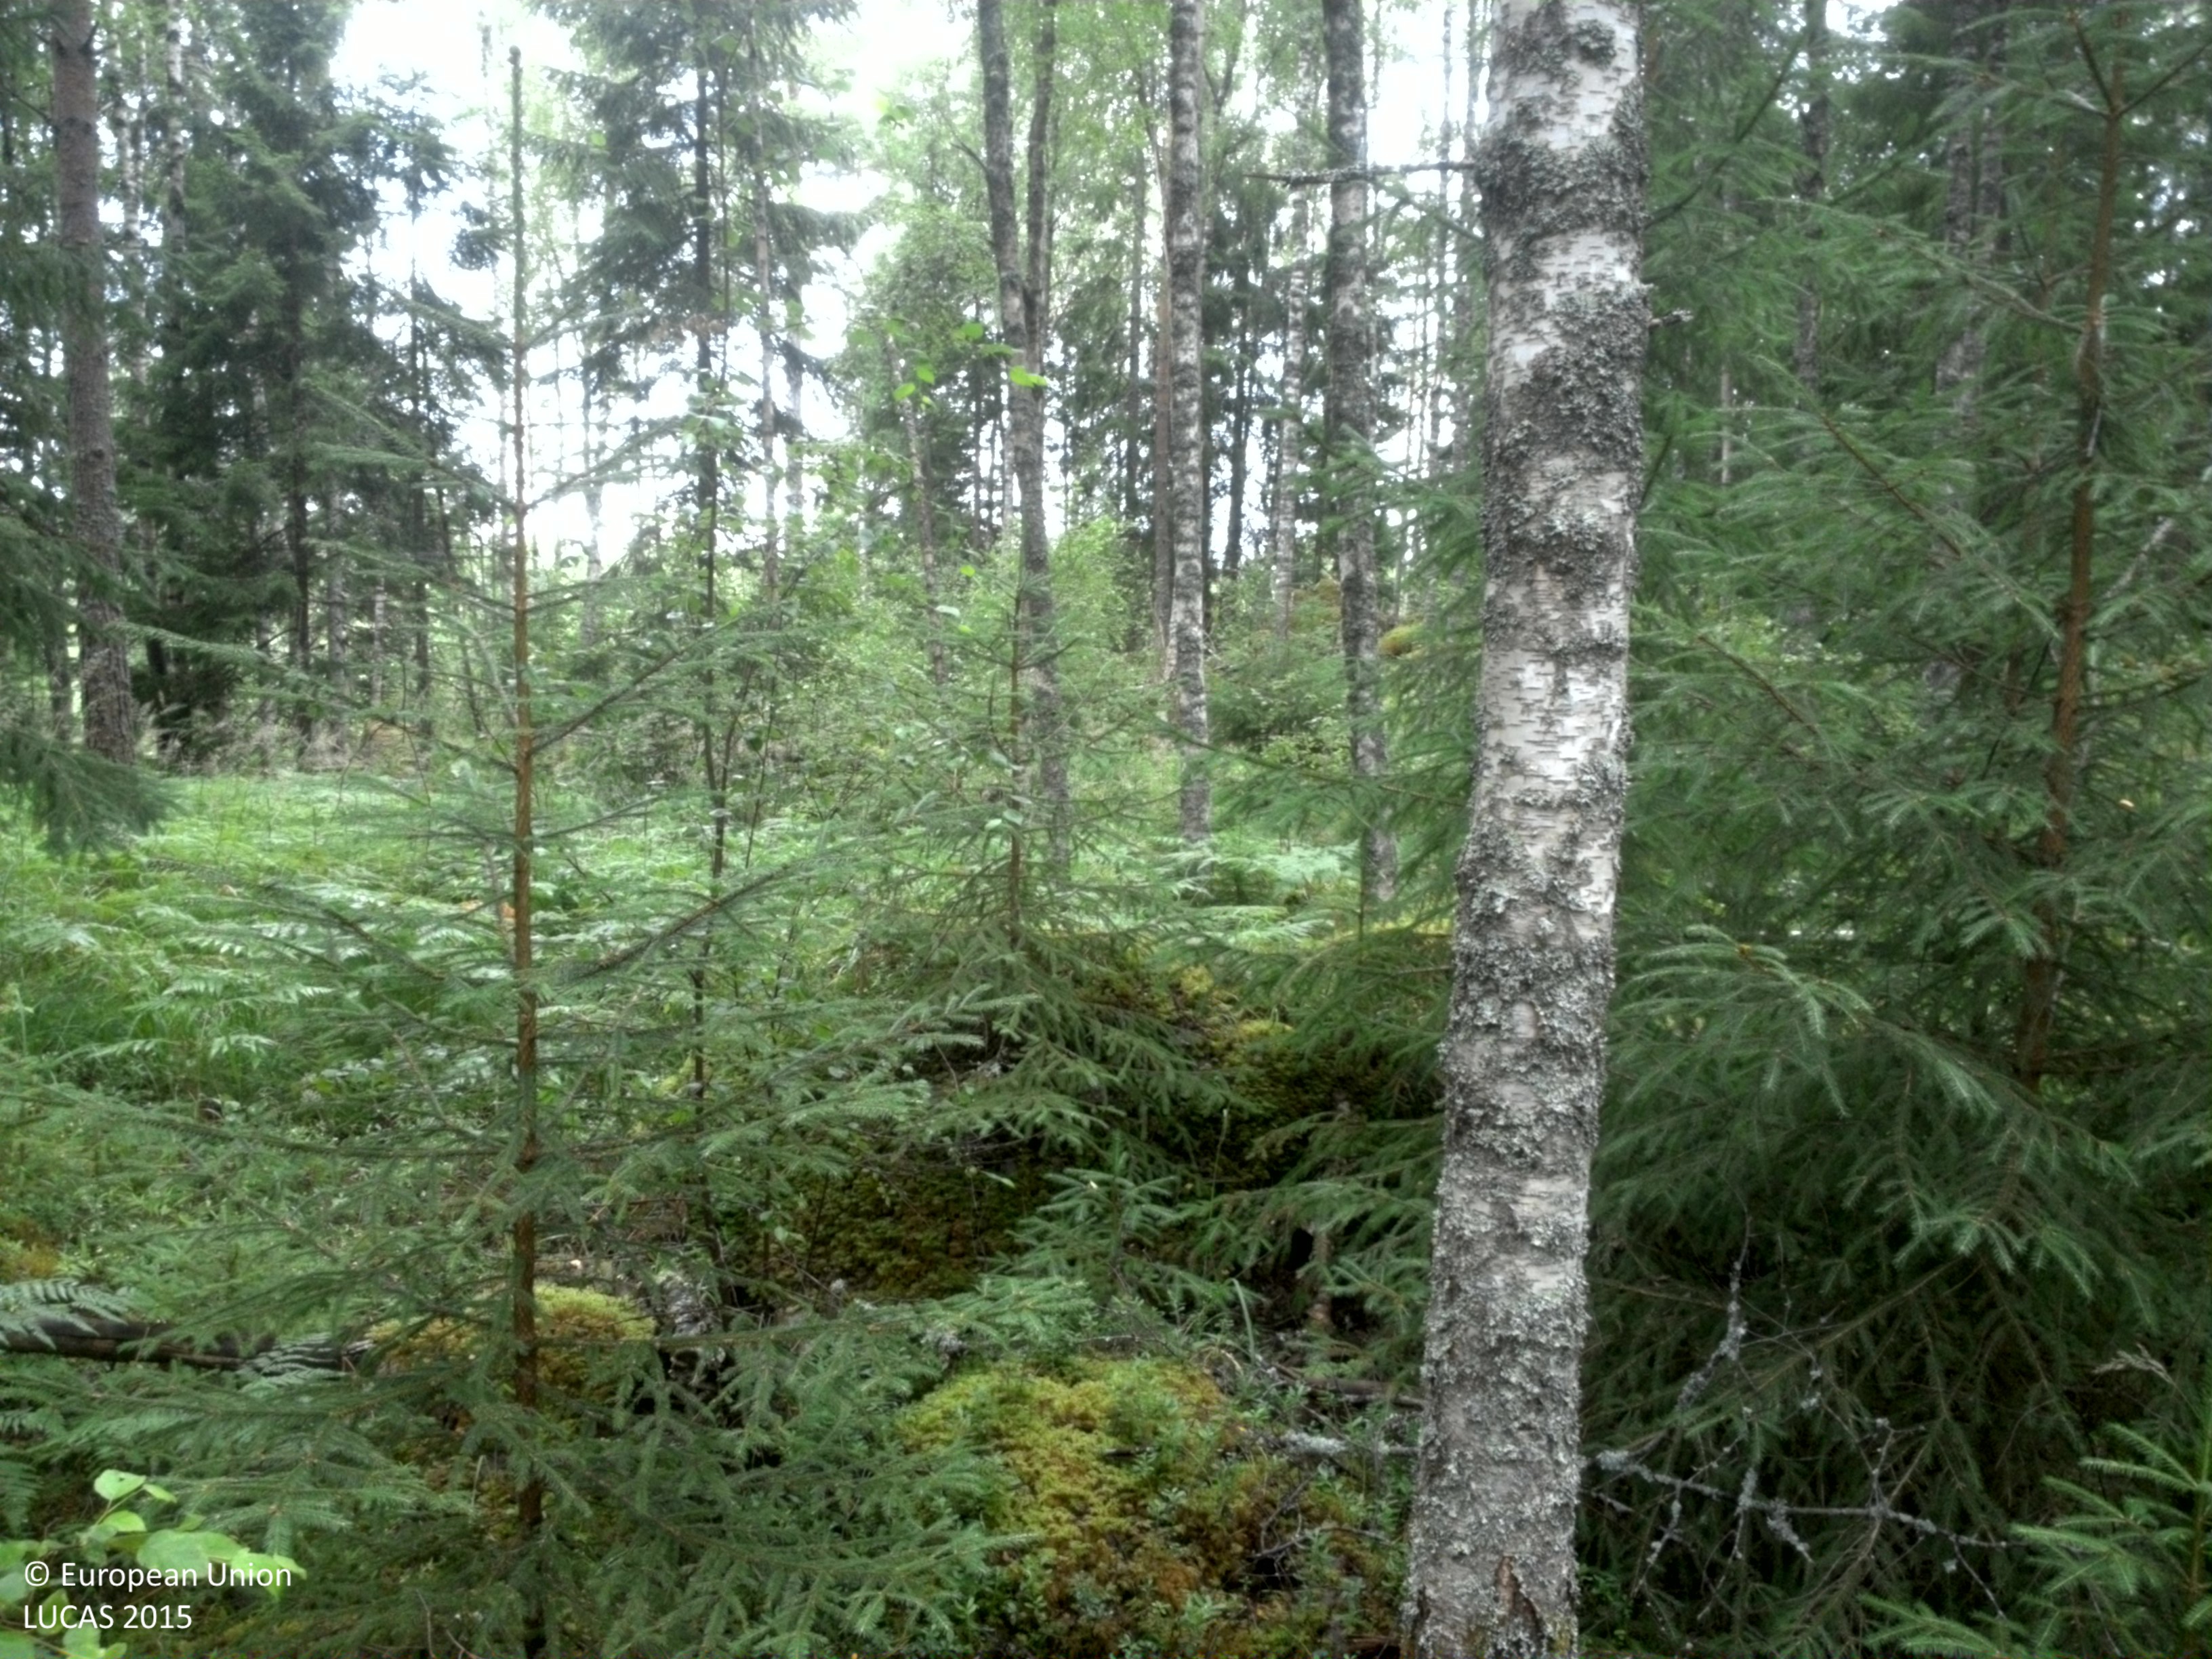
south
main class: Woodland
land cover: Other mixed woodland
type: boreal forest
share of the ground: > 75 %
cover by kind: broadleaved forest trees 45 %, coniferous forest trees 30 %, herbaceous plants 15 %, shrubs 5 %, lichens and mosses 5 %
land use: Forestry
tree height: > 5 m
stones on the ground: > 50 %
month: July
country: SE
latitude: 59.6855
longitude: 14.2002
